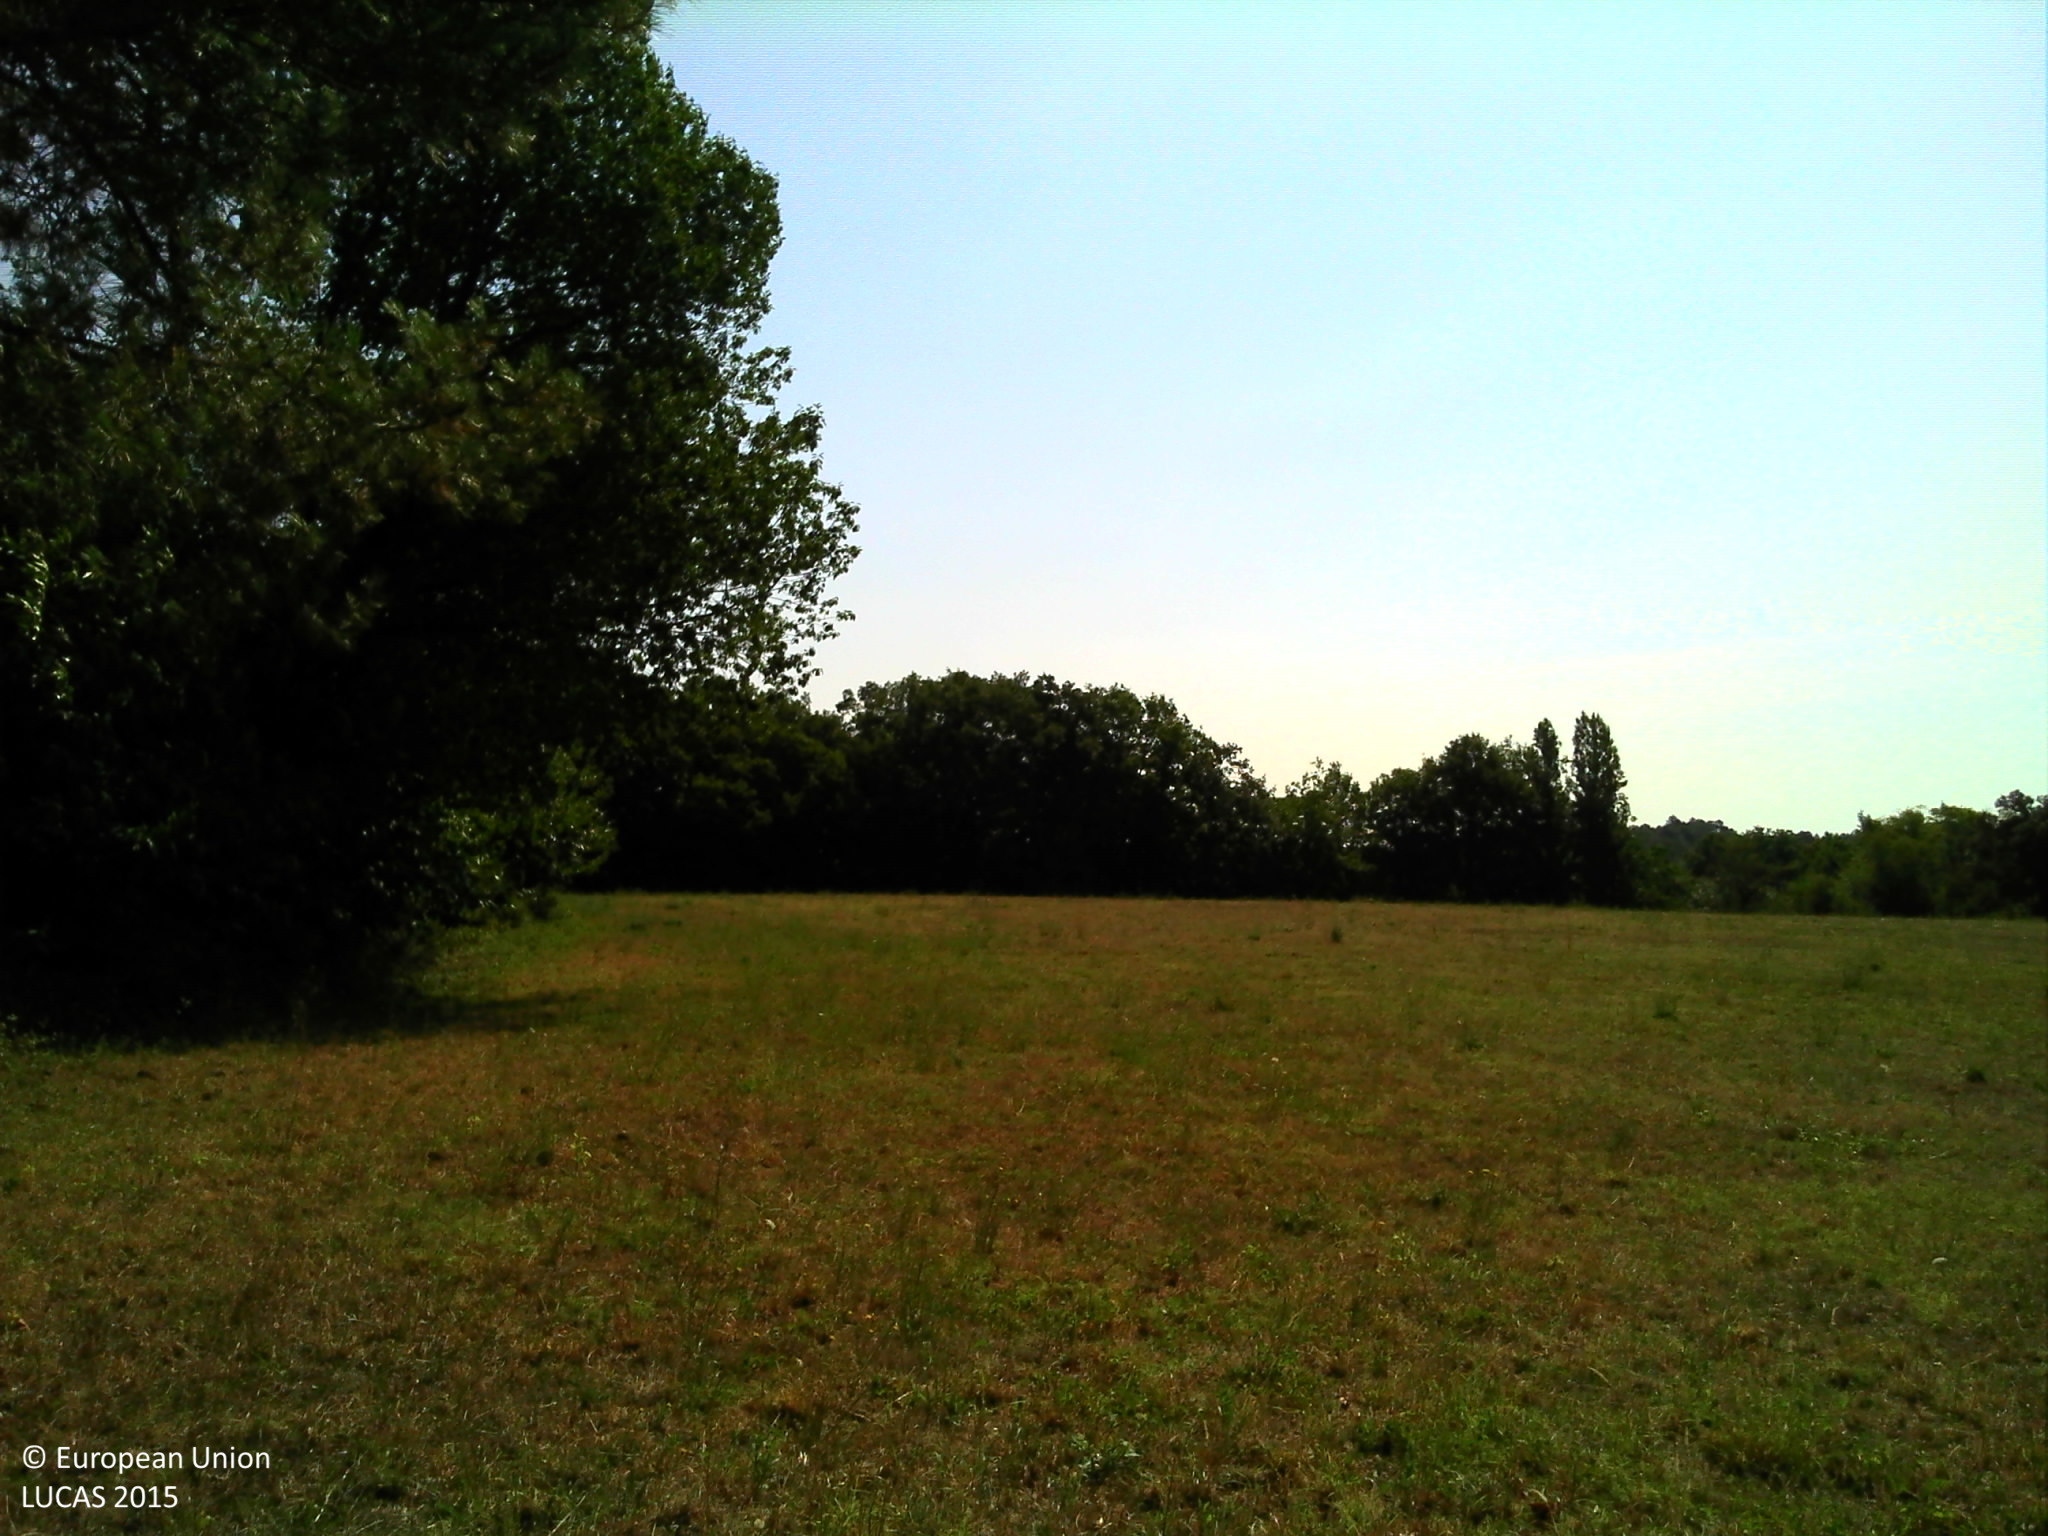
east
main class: Grassland
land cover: Grassland without tree/shrub cover
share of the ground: > 75 %
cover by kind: herbaceous plants 95 %, shrubs 5 %
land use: Agriculture (excluding fallow land and kitchen gardens)
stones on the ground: < 10 %
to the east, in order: Grassland without tree/shrub cover; Broadleaved woodland; Grassland without tree/shrub cover; Spontaneously vegetated surfaces; Fences; Grassland with sparse tree/shrub cover
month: August
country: FR
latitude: 44.6791
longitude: 1.1518
